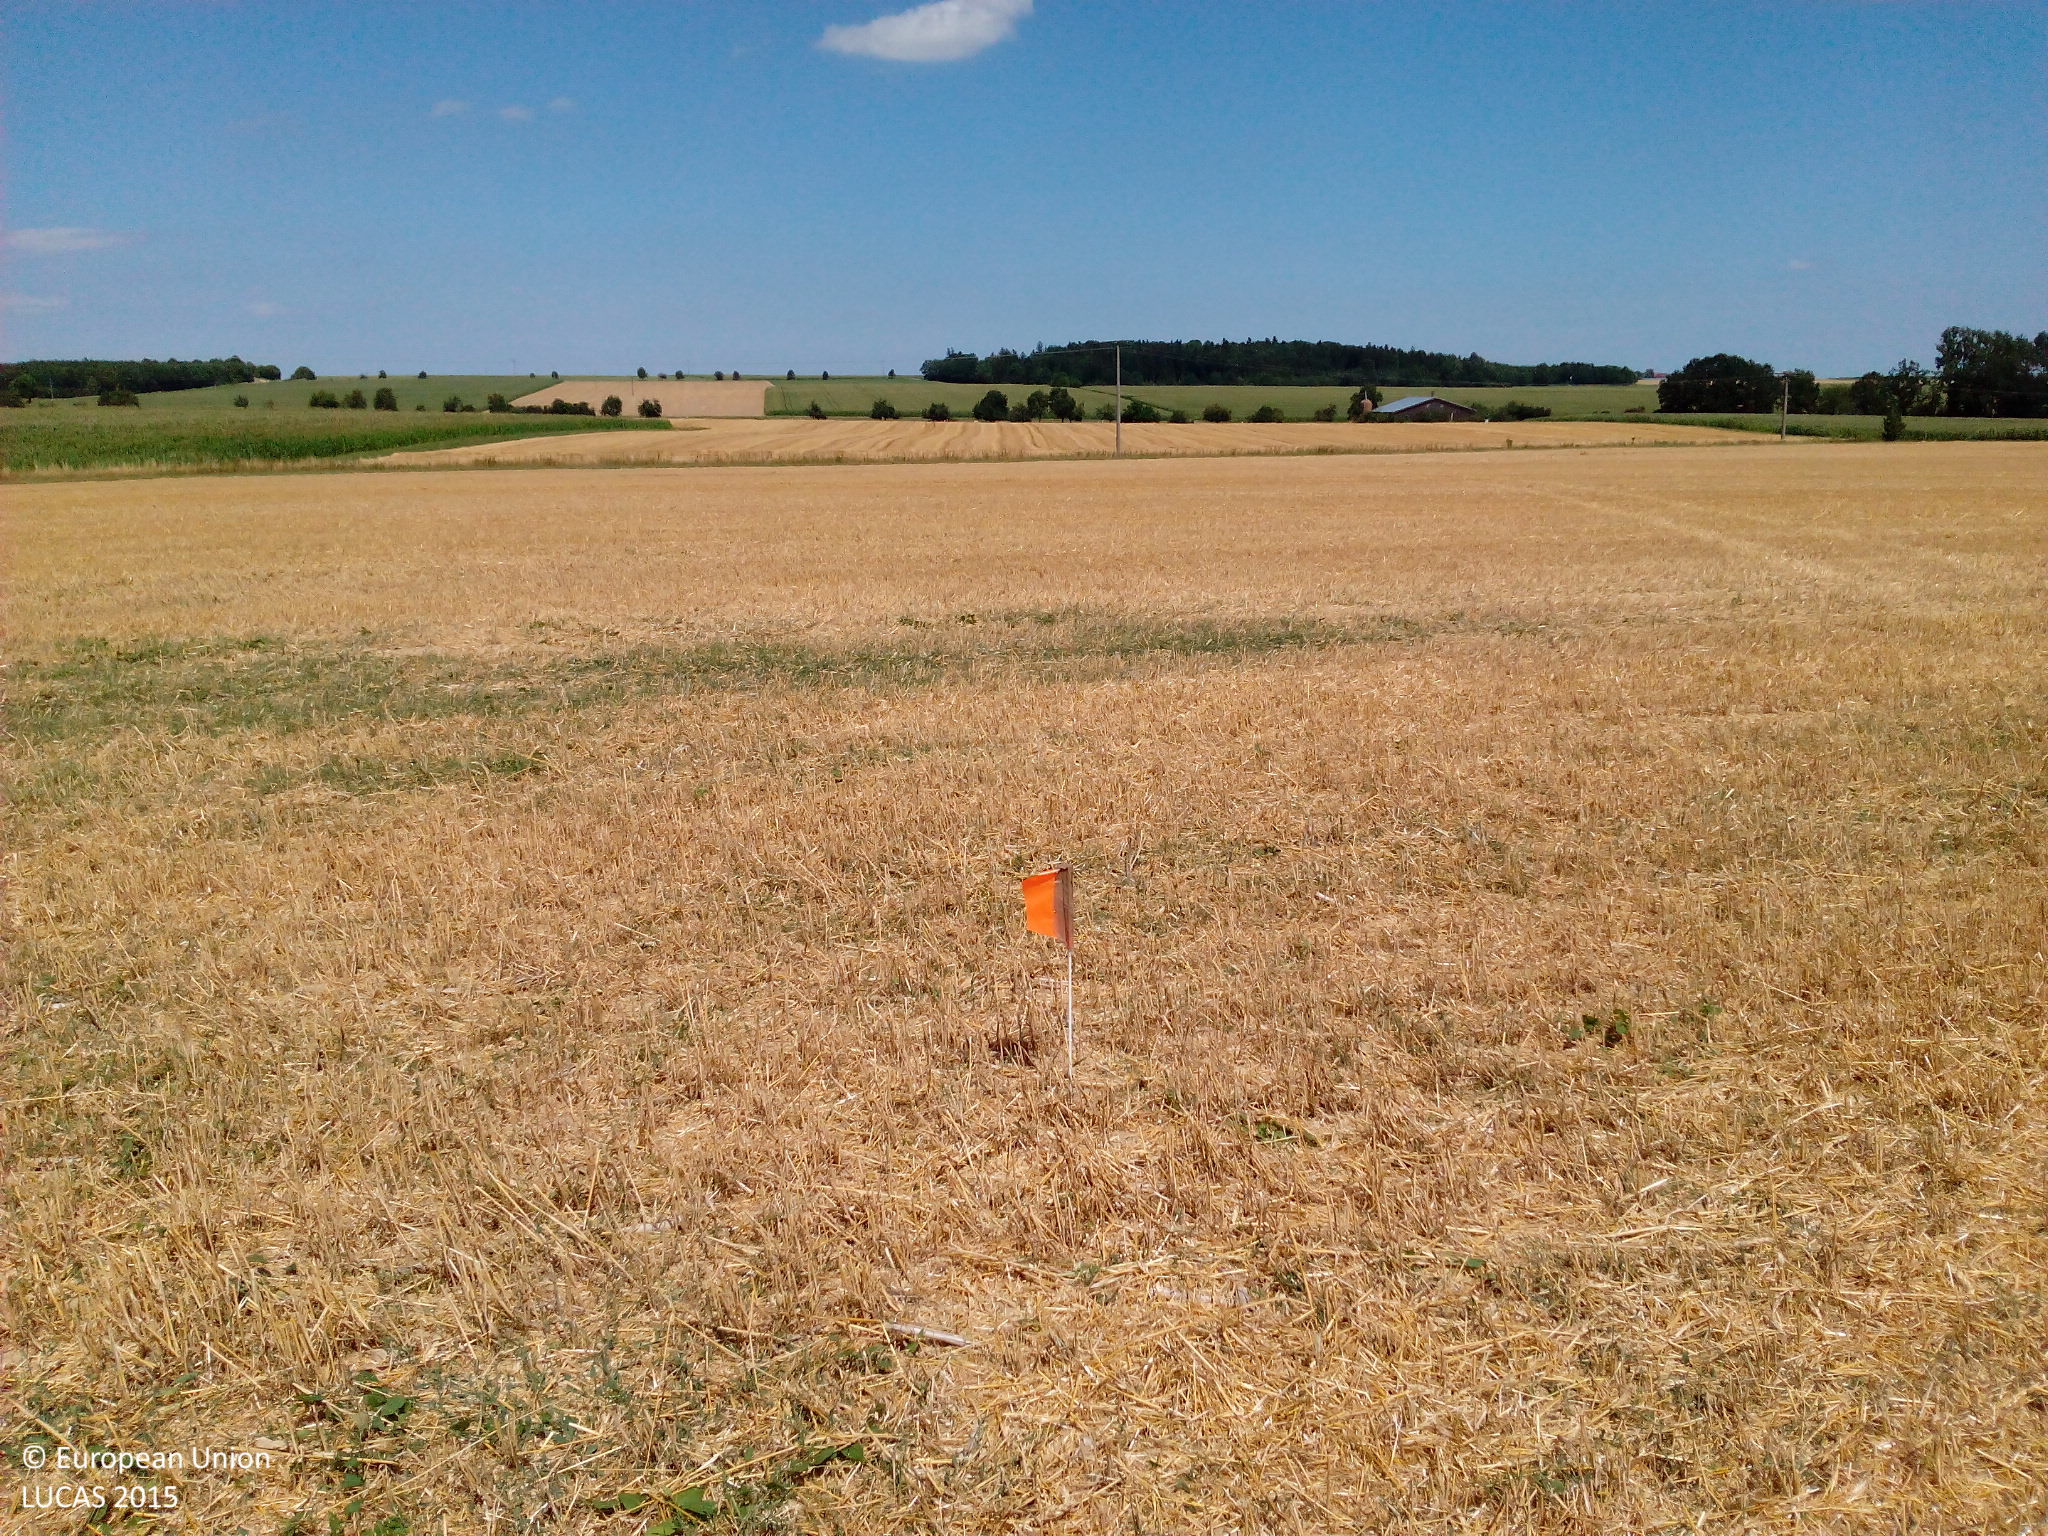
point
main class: Cropland
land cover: Common wheat
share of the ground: < 10 %
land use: Agriculture (excluding fallow land and kitchen gardens)
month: August
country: DE
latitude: 48.9788
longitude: 10.3141
